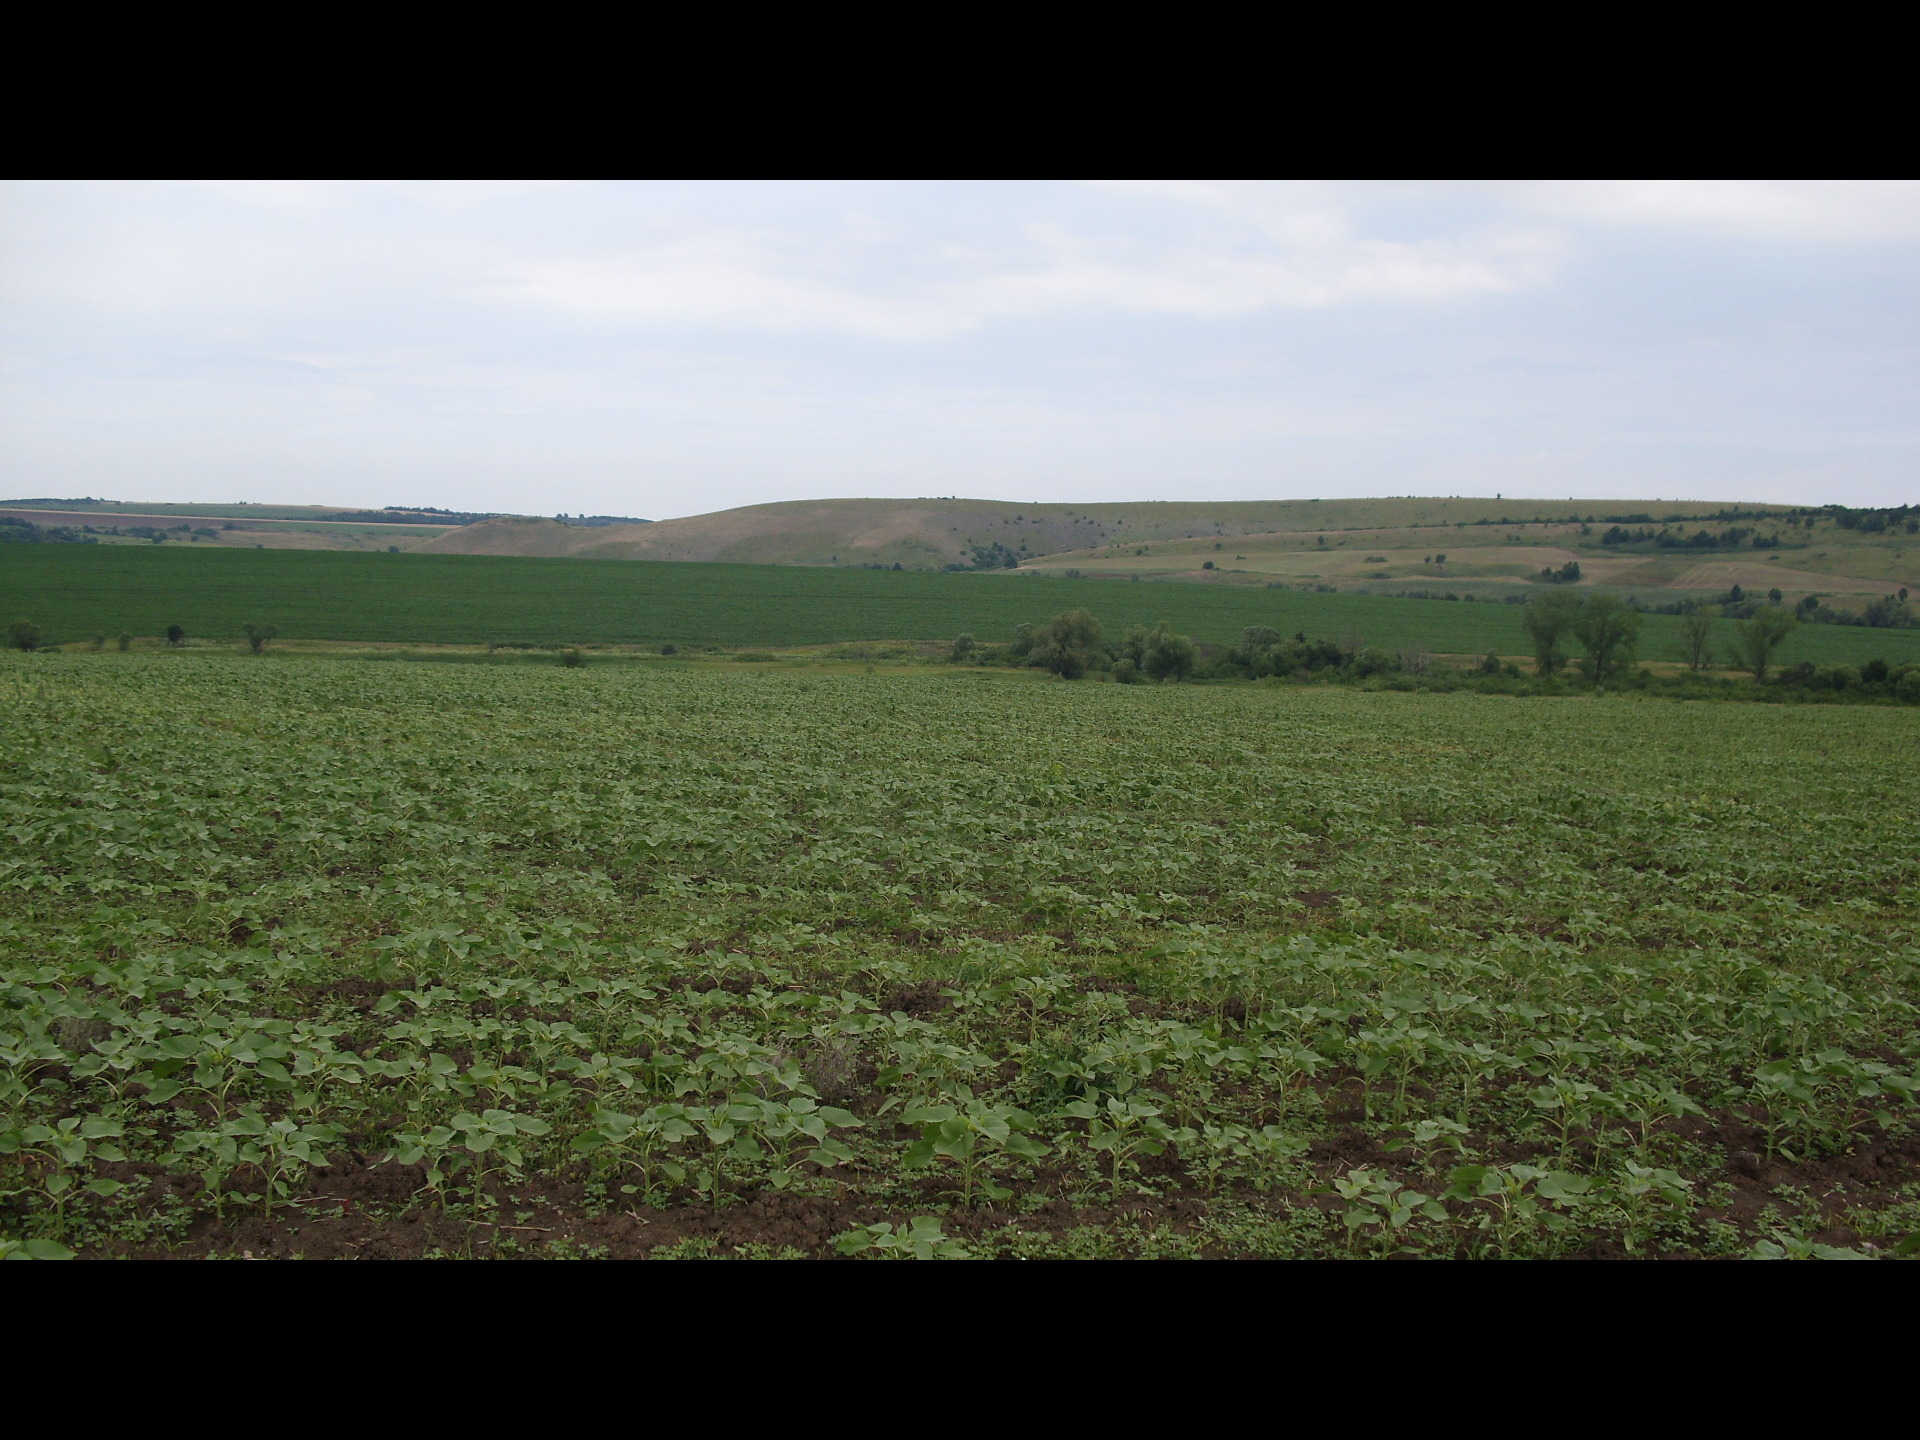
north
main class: Cropland
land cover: Sunflower
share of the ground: 25 - 50 %
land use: Agriculture (excluding fallow land and kitchen gardens)
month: June
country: BG
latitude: 43.4422
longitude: 23.5245
